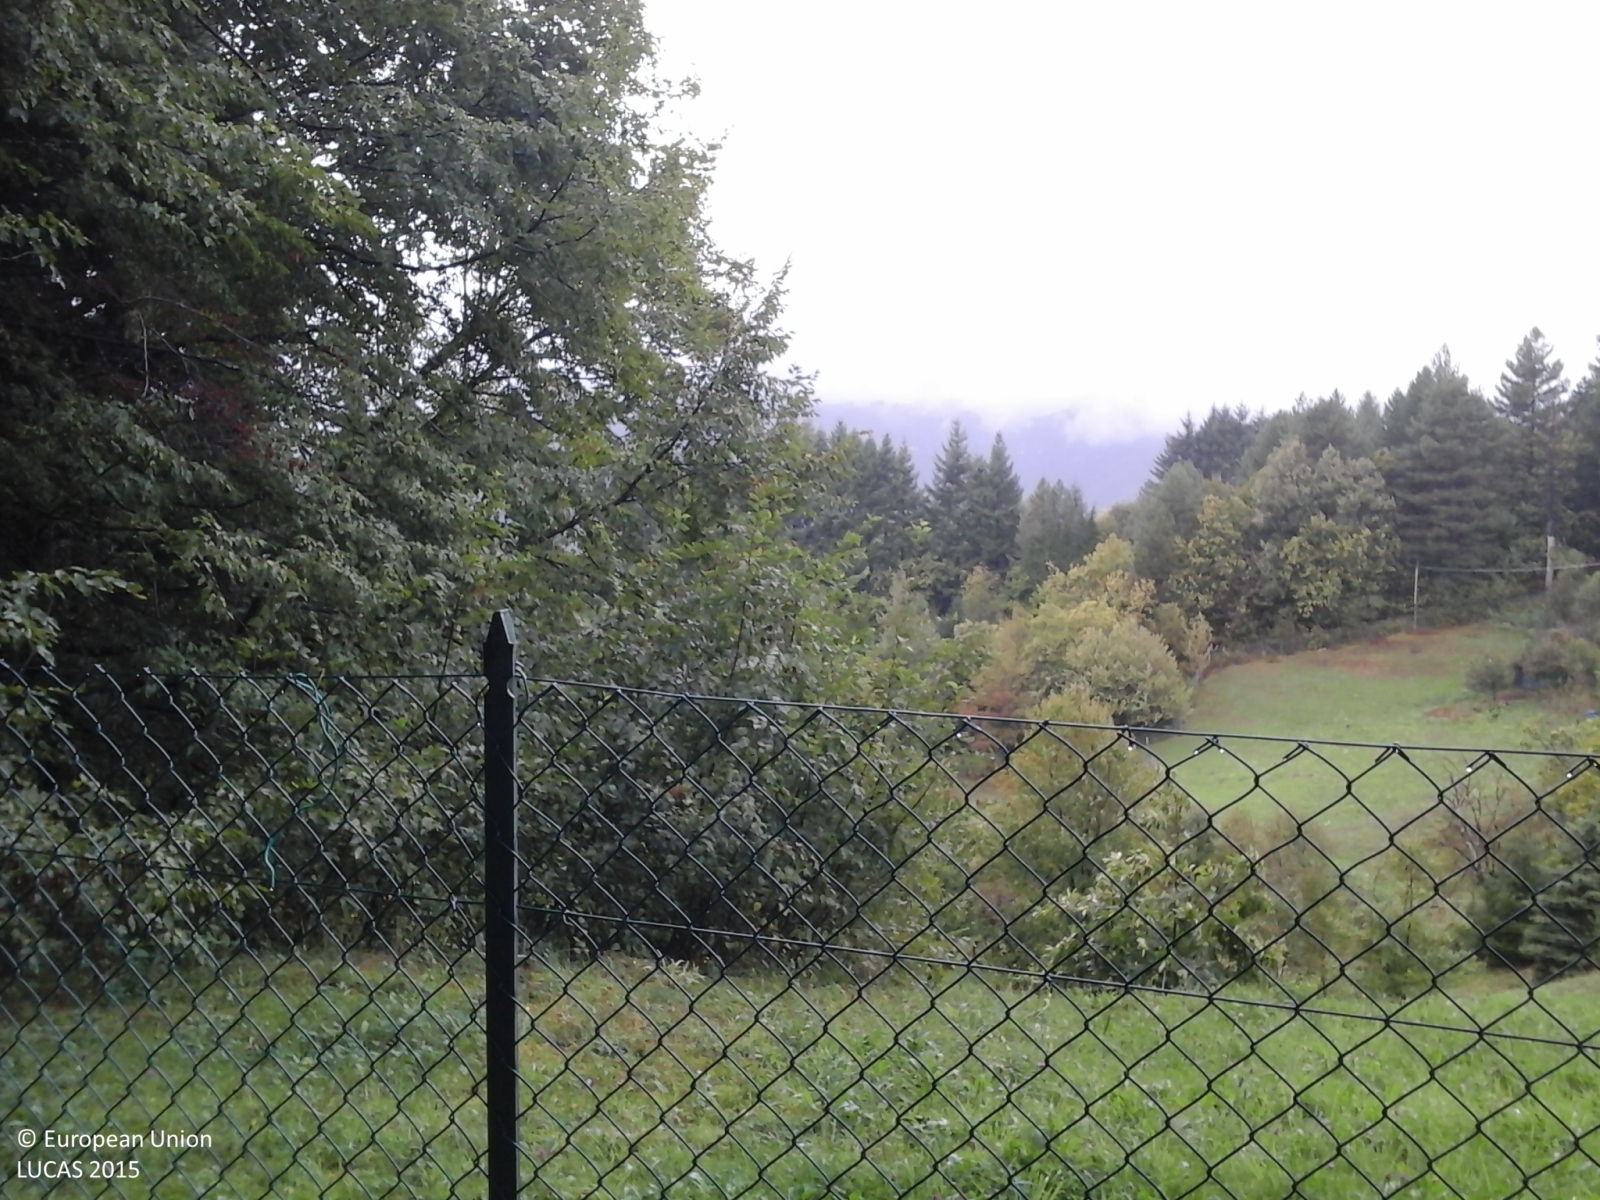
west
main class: Woodland
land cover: Other mixed woodland
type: coniferous forest of the mediterranean region
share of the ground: > 75 %
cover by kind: broadleaved forest trees 60 %, coniferous forest trees 30 %, herbaceous plants 10 %
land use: Semi-natural and natural areas not in use
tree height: > 5 m
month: September
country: IT
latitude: 44.4389
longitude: 9.3858
